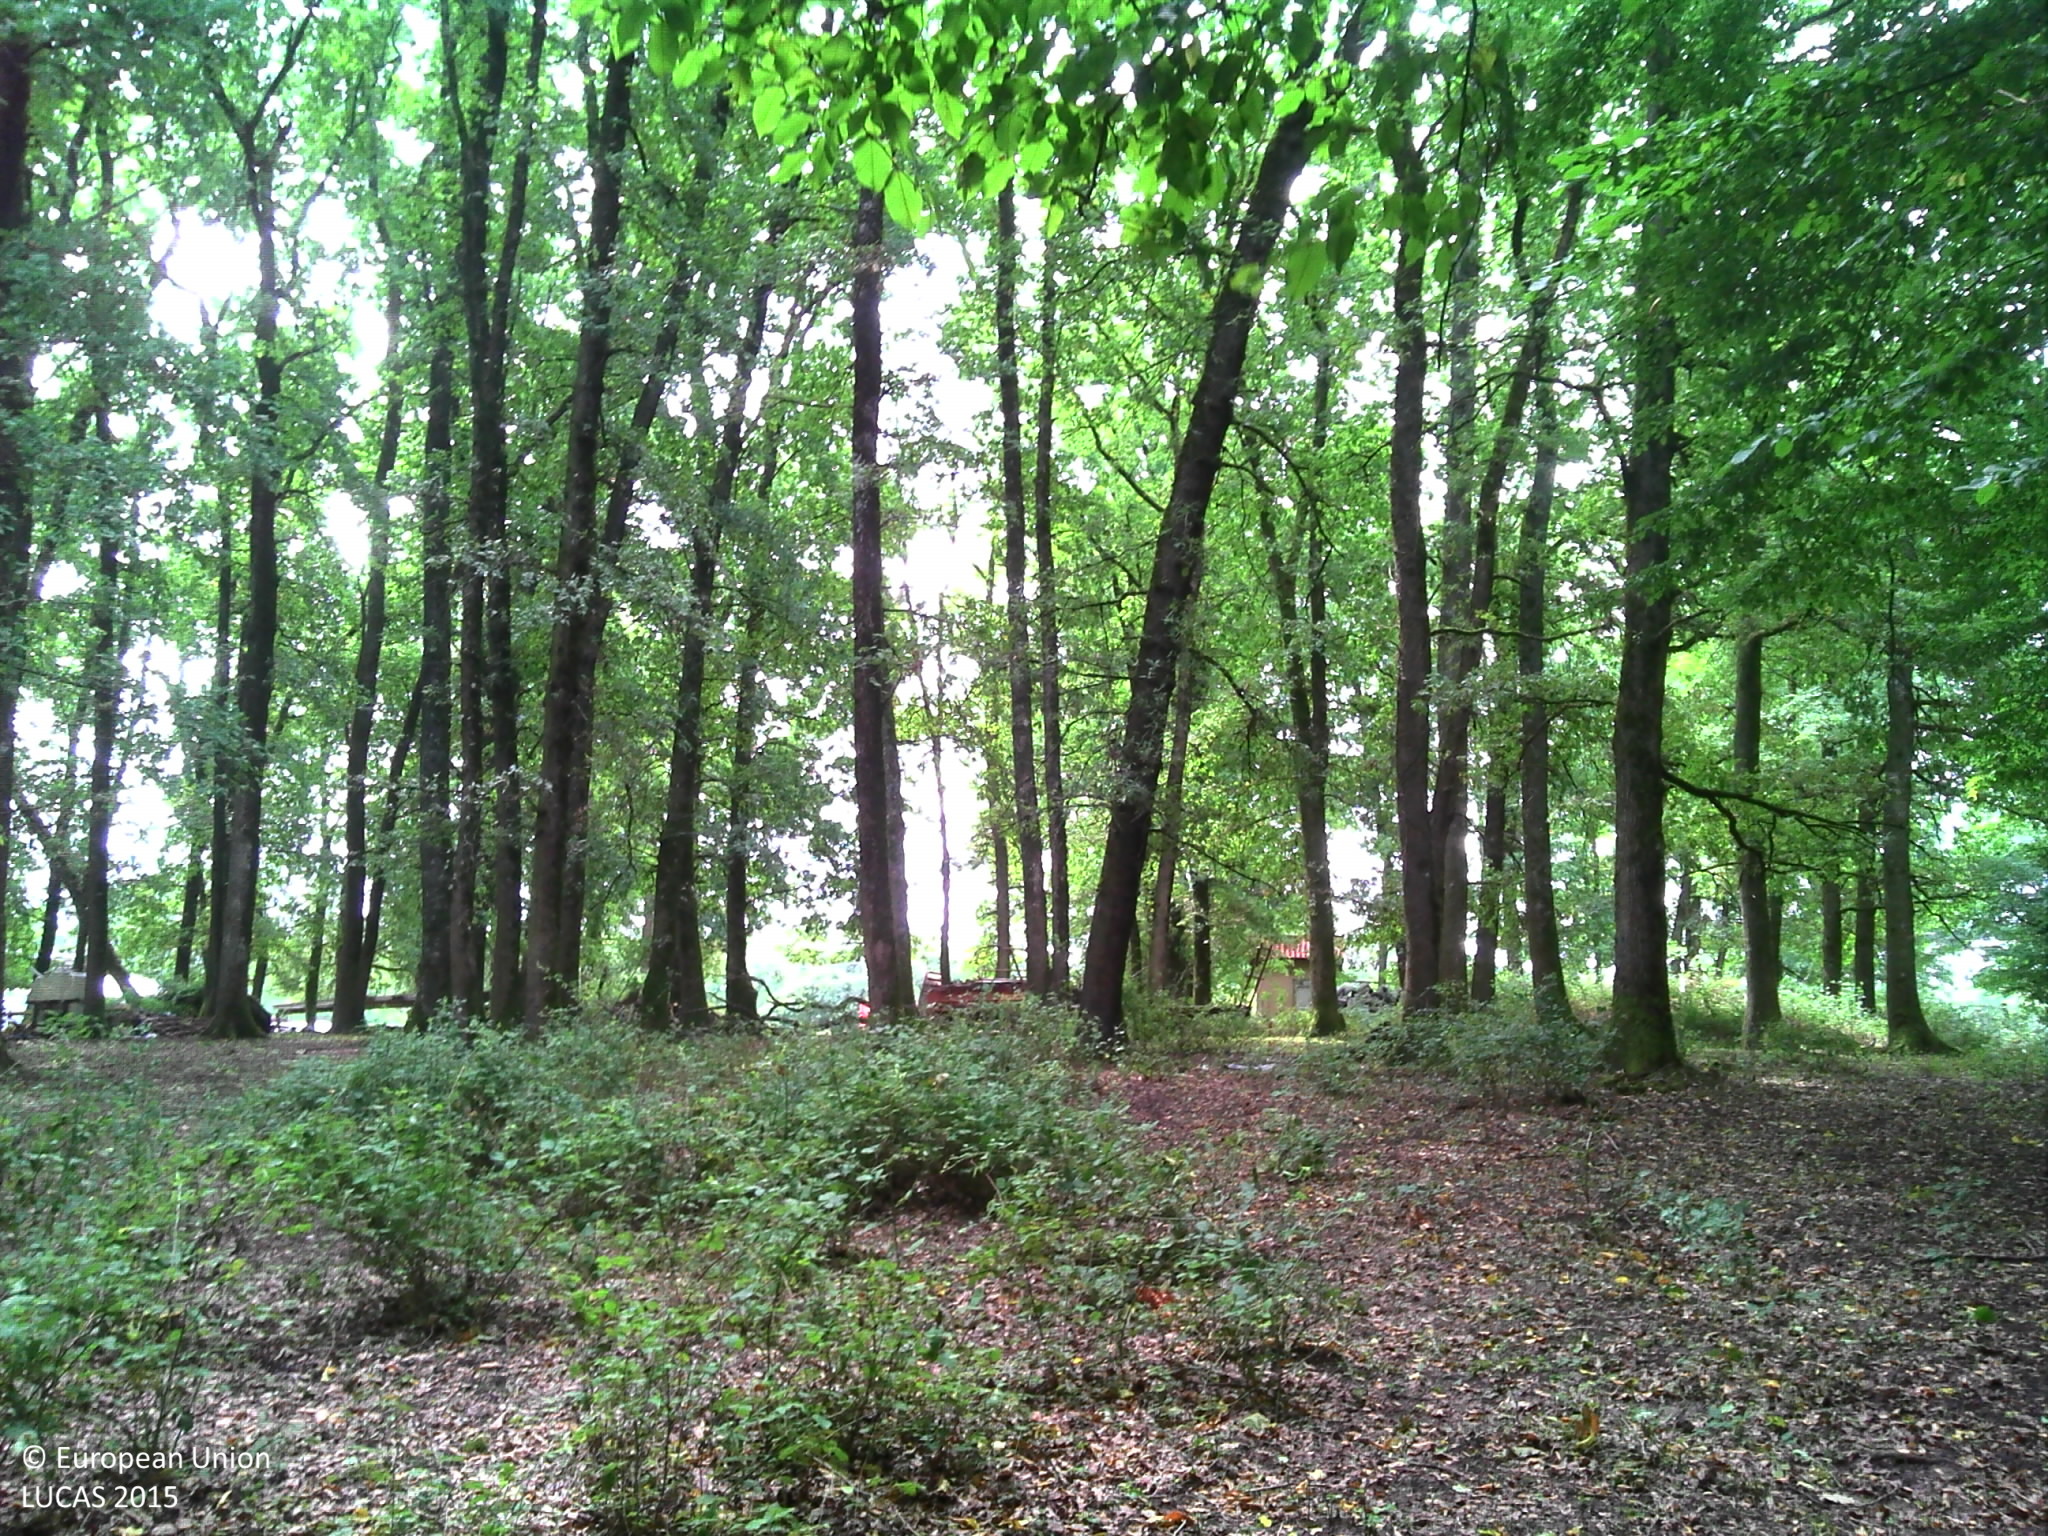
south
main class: Woodland
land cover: Broadleaved woodland
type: mesophytic deciduous forest
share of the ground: > 75 %
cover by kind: broadleaved forest trees 85 %, unconsolidated bare surface 10 %, herbaceous plants 5 %
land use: Forestry
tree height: > 5 m
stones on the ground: < 10 %
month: August
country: FR
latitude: 45.3077
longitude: 0.6658
